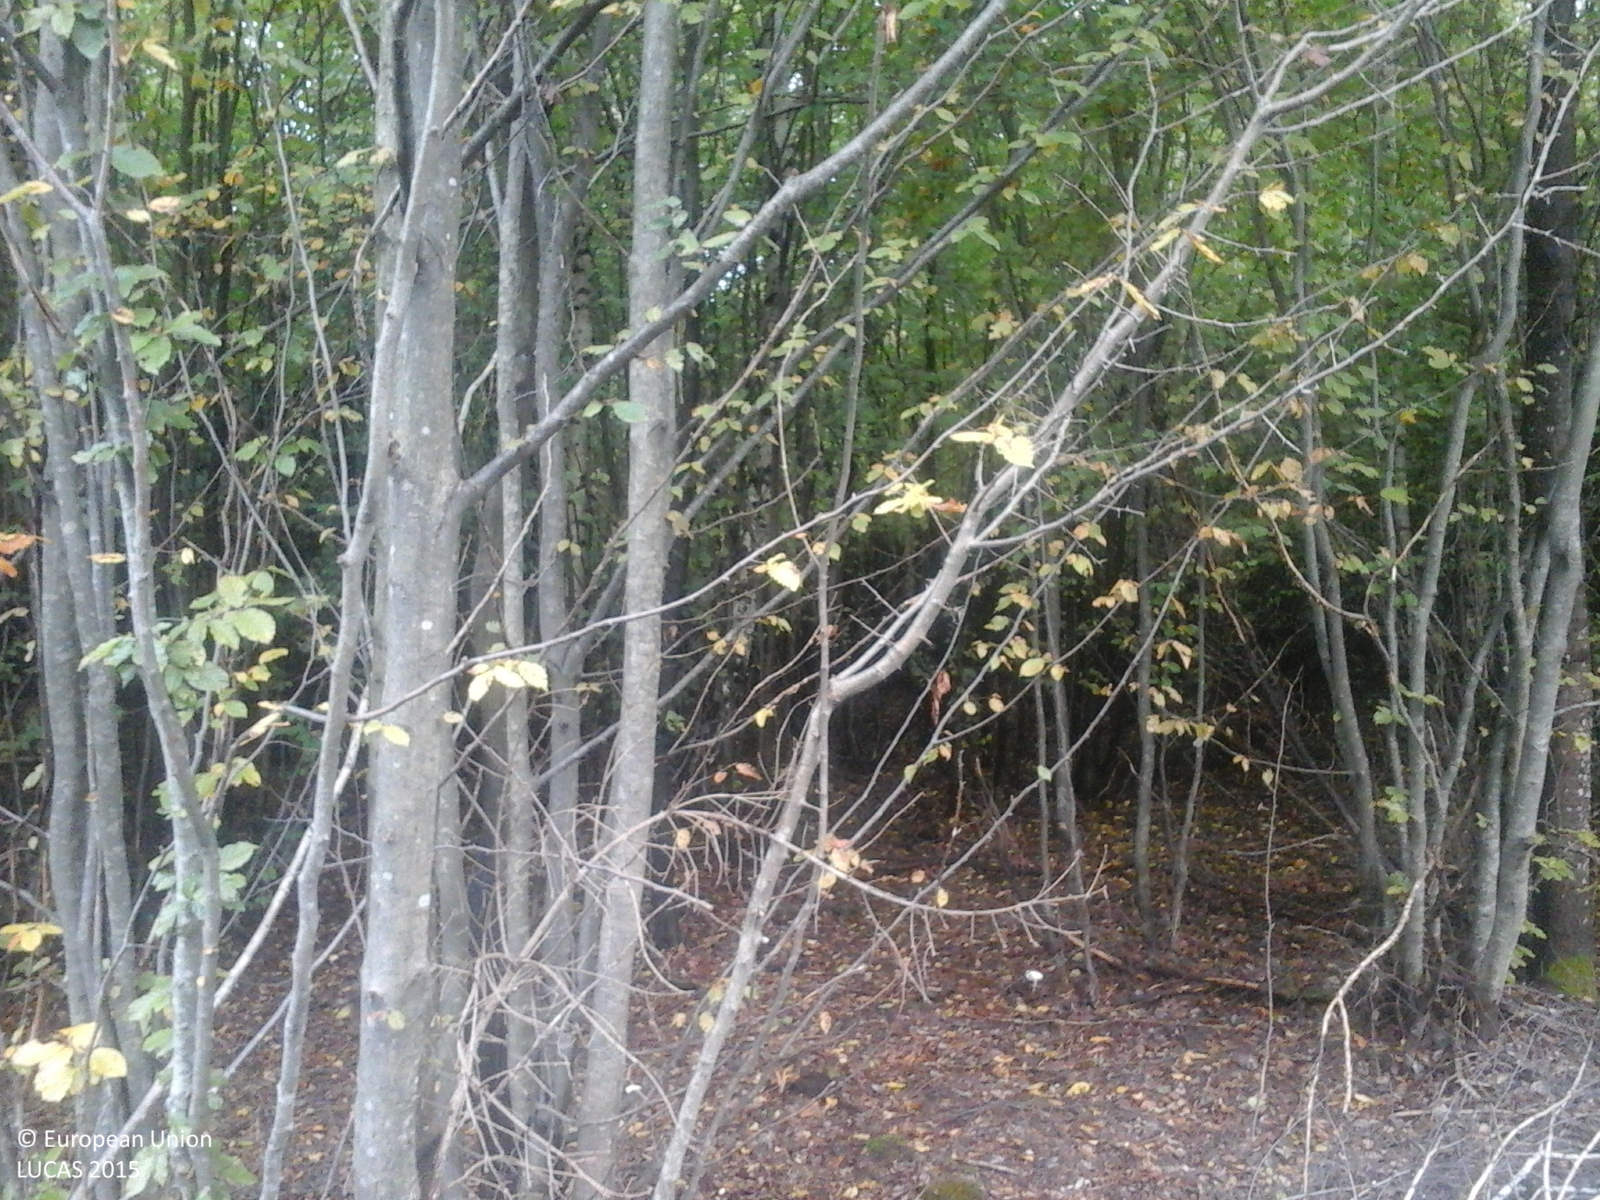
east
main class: Woodland
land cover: Broadleaved woodland
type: beech forest
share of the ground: > 75 %
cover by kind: broadleaved forest trees 100 %
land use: Forestry
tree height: > 5 m
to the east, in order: Broadleaved woodland
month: October
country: RO
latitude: 45.7035
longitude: 24.7672
